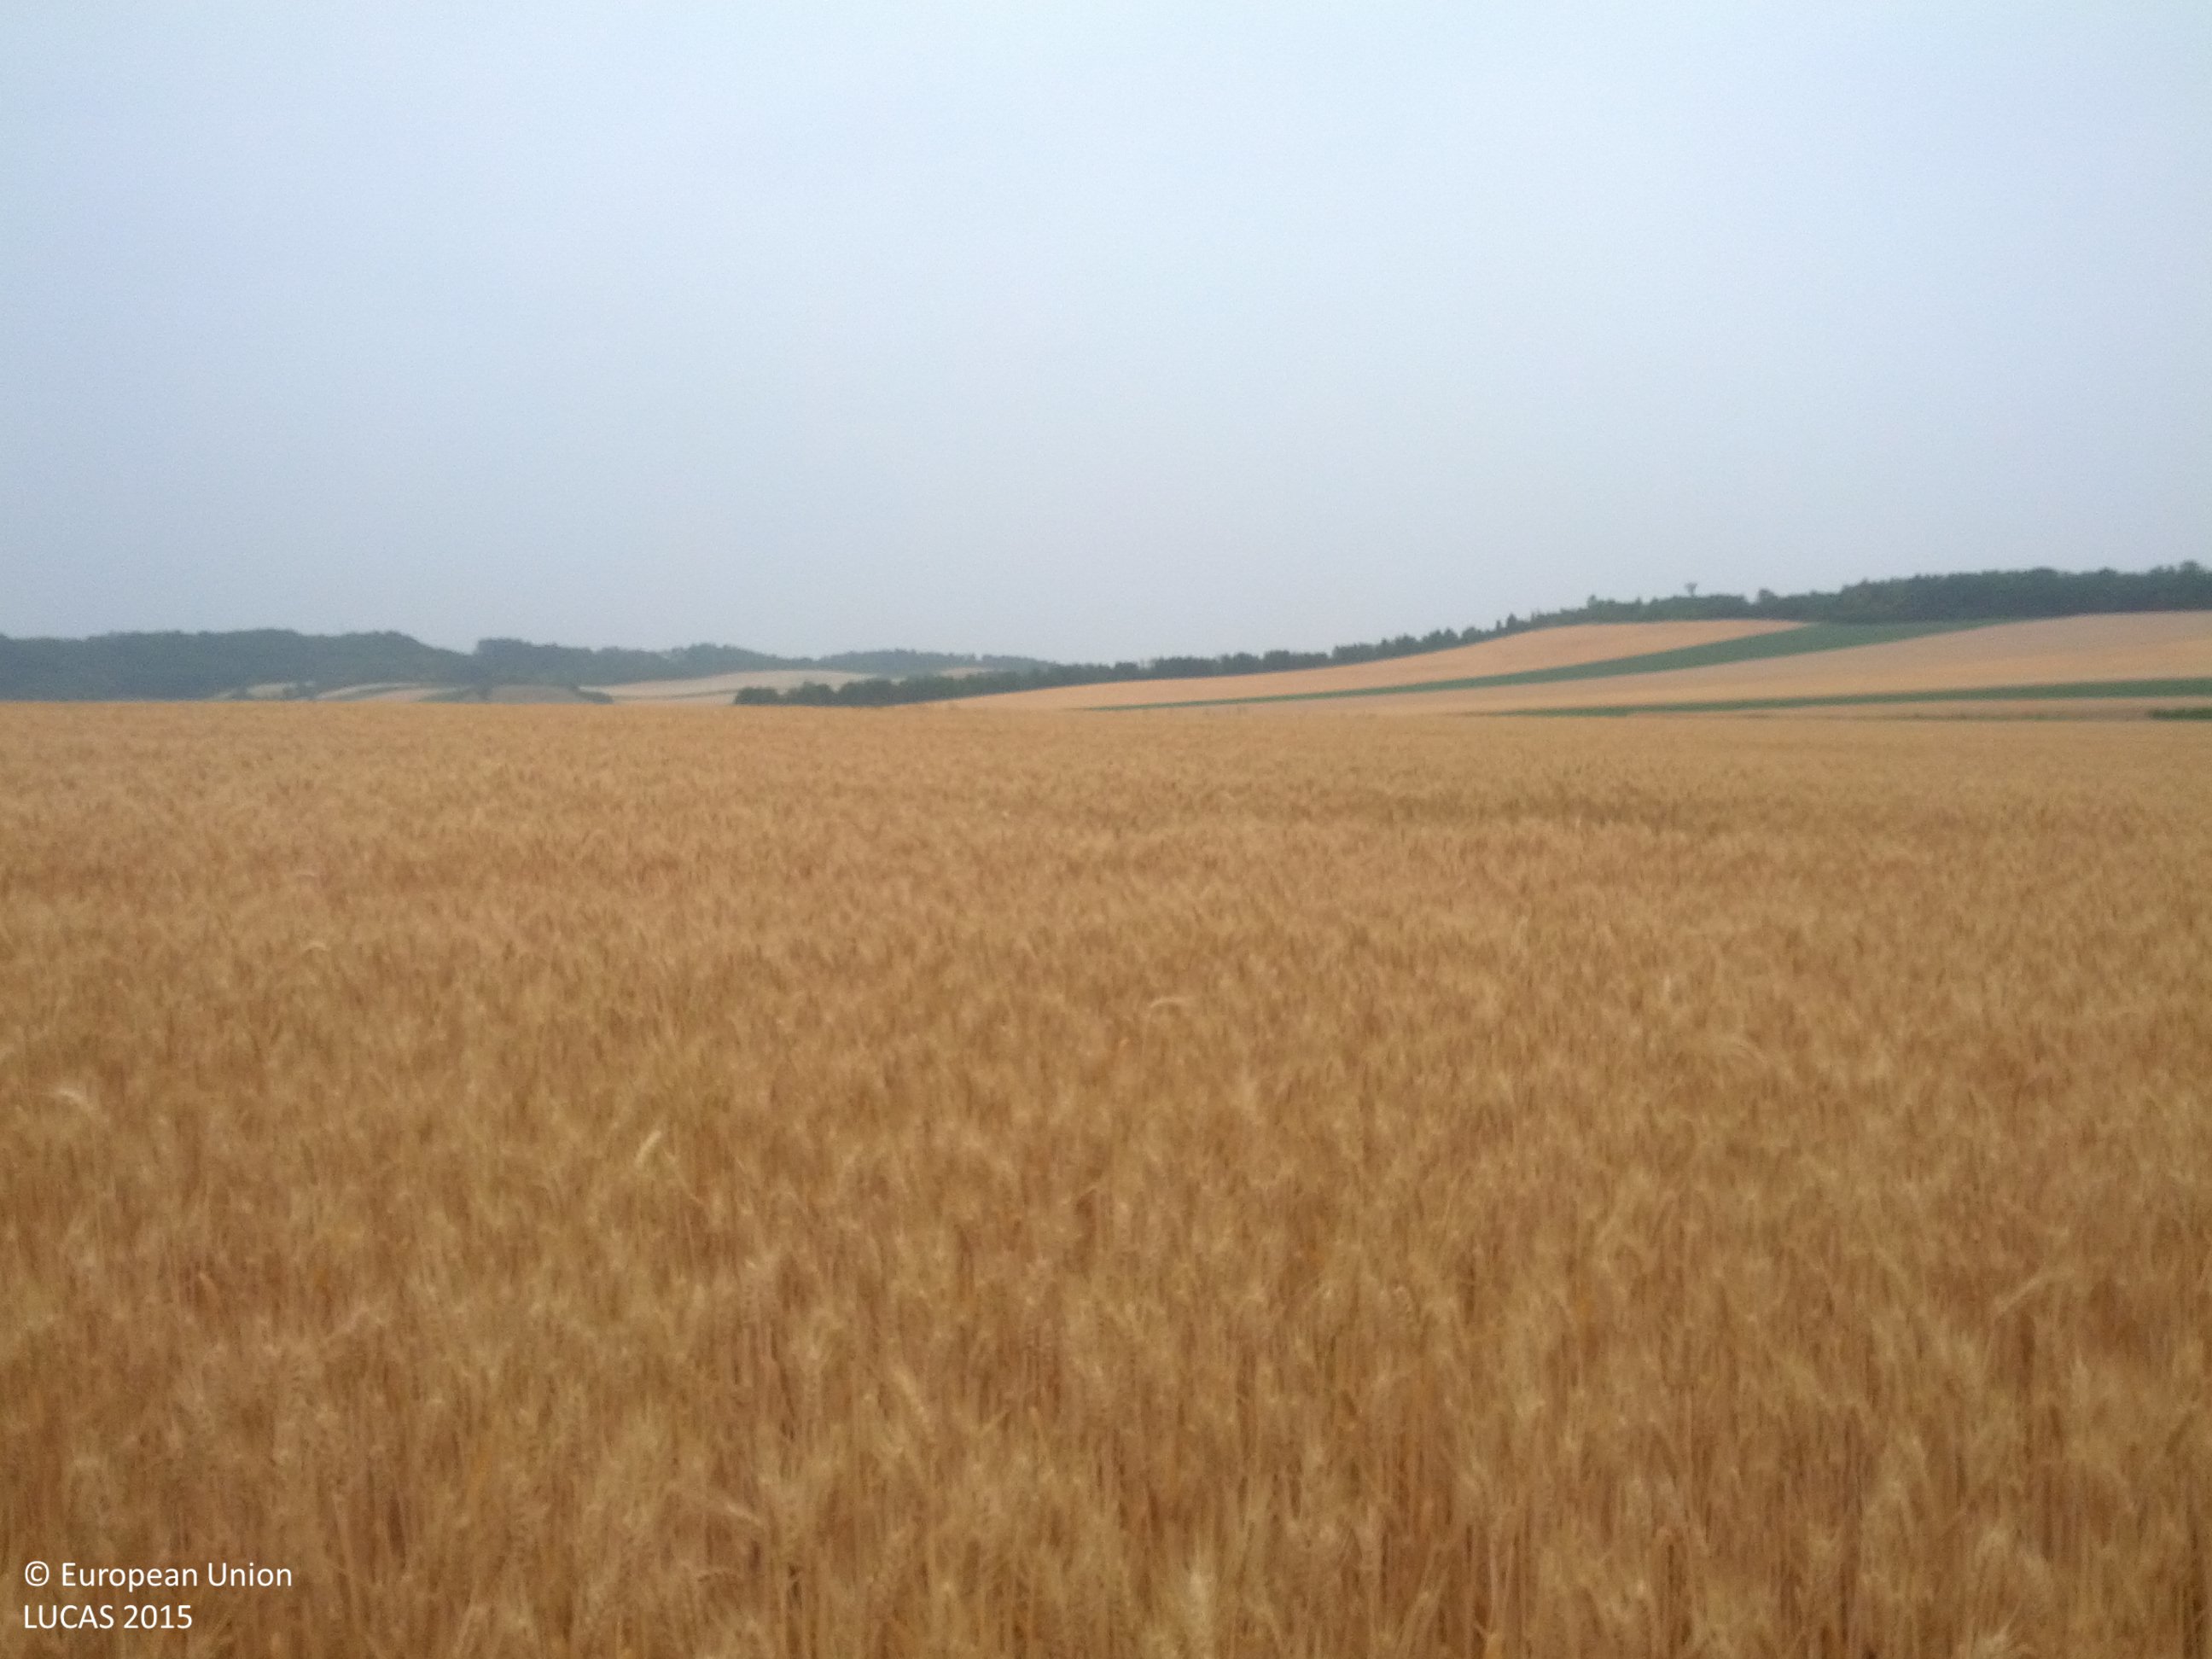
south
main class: Cropland
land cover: Common wheat
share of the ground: > 75 %
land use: Agriculture (excluding fallow land and kitchen gardens)
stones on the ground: 10 - 25 %
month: July
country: AT
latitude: 48.7703
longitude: 16.5239
